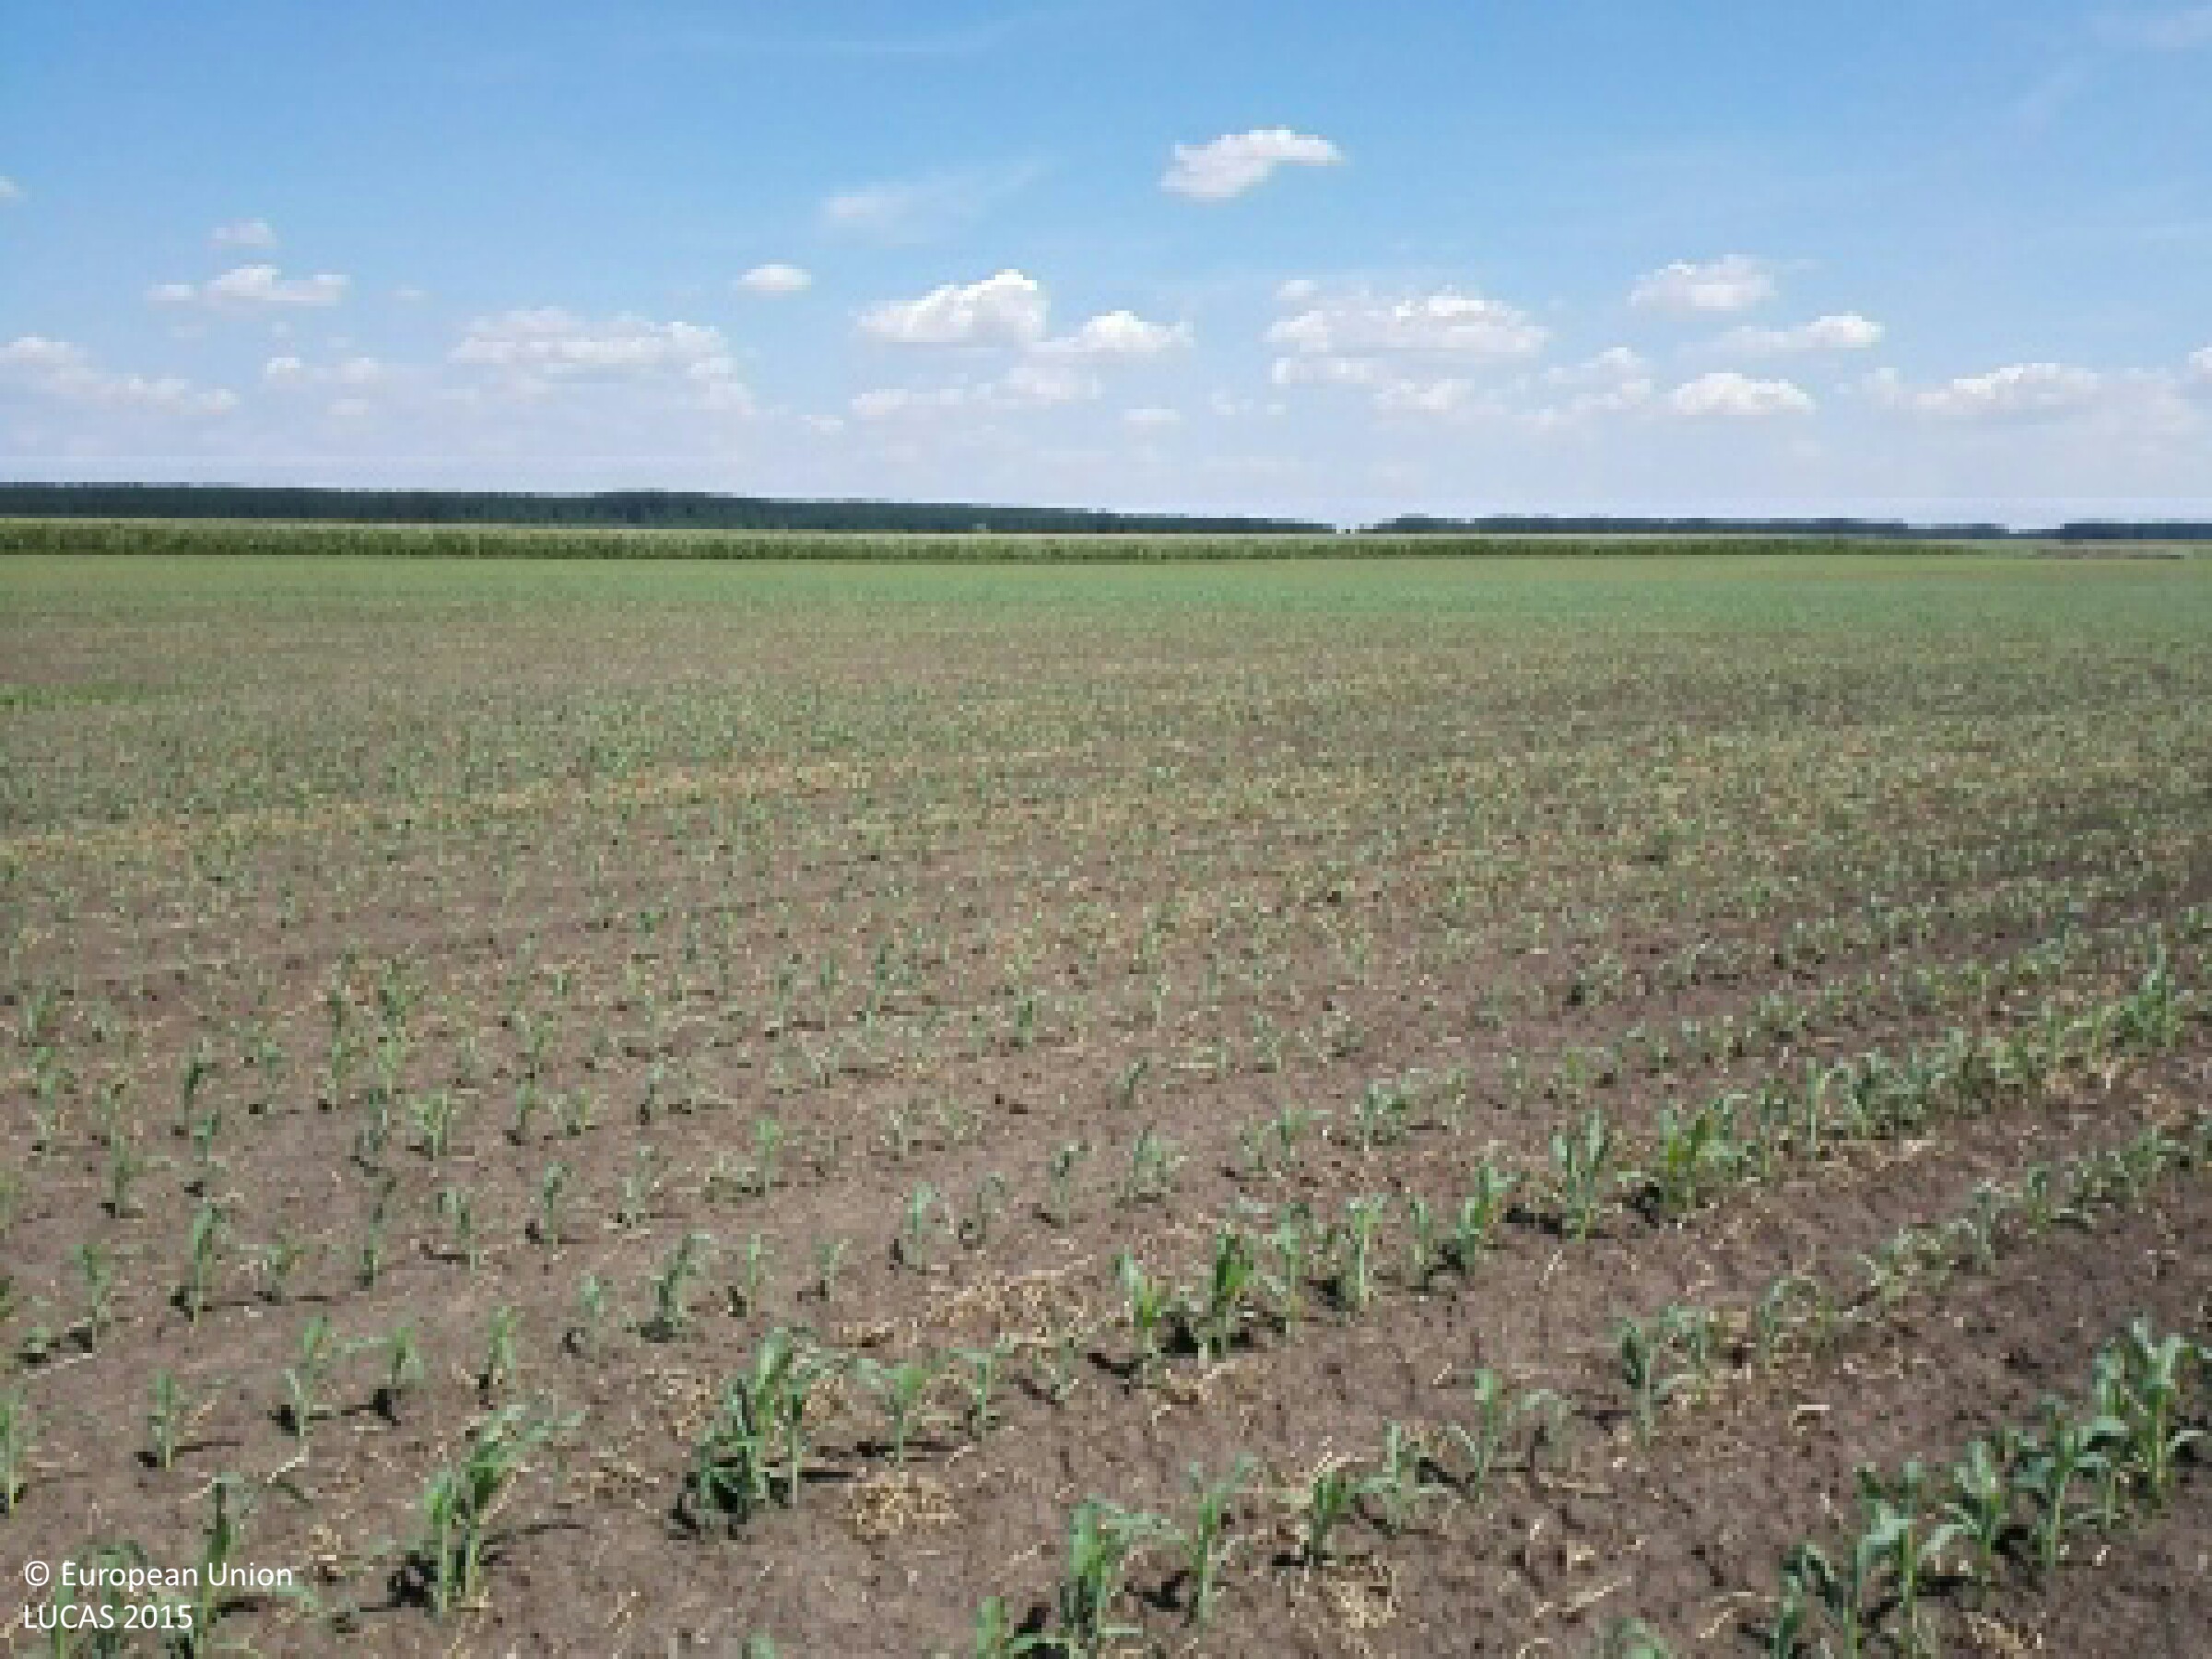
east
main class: Cropland
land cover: Maize
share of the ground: 10 - 25 %
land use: Agriculture (excluding fallow land and kitchen gardens)
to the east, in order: Maize
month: July
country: HU
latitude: 47.3998
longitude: 21.3427
